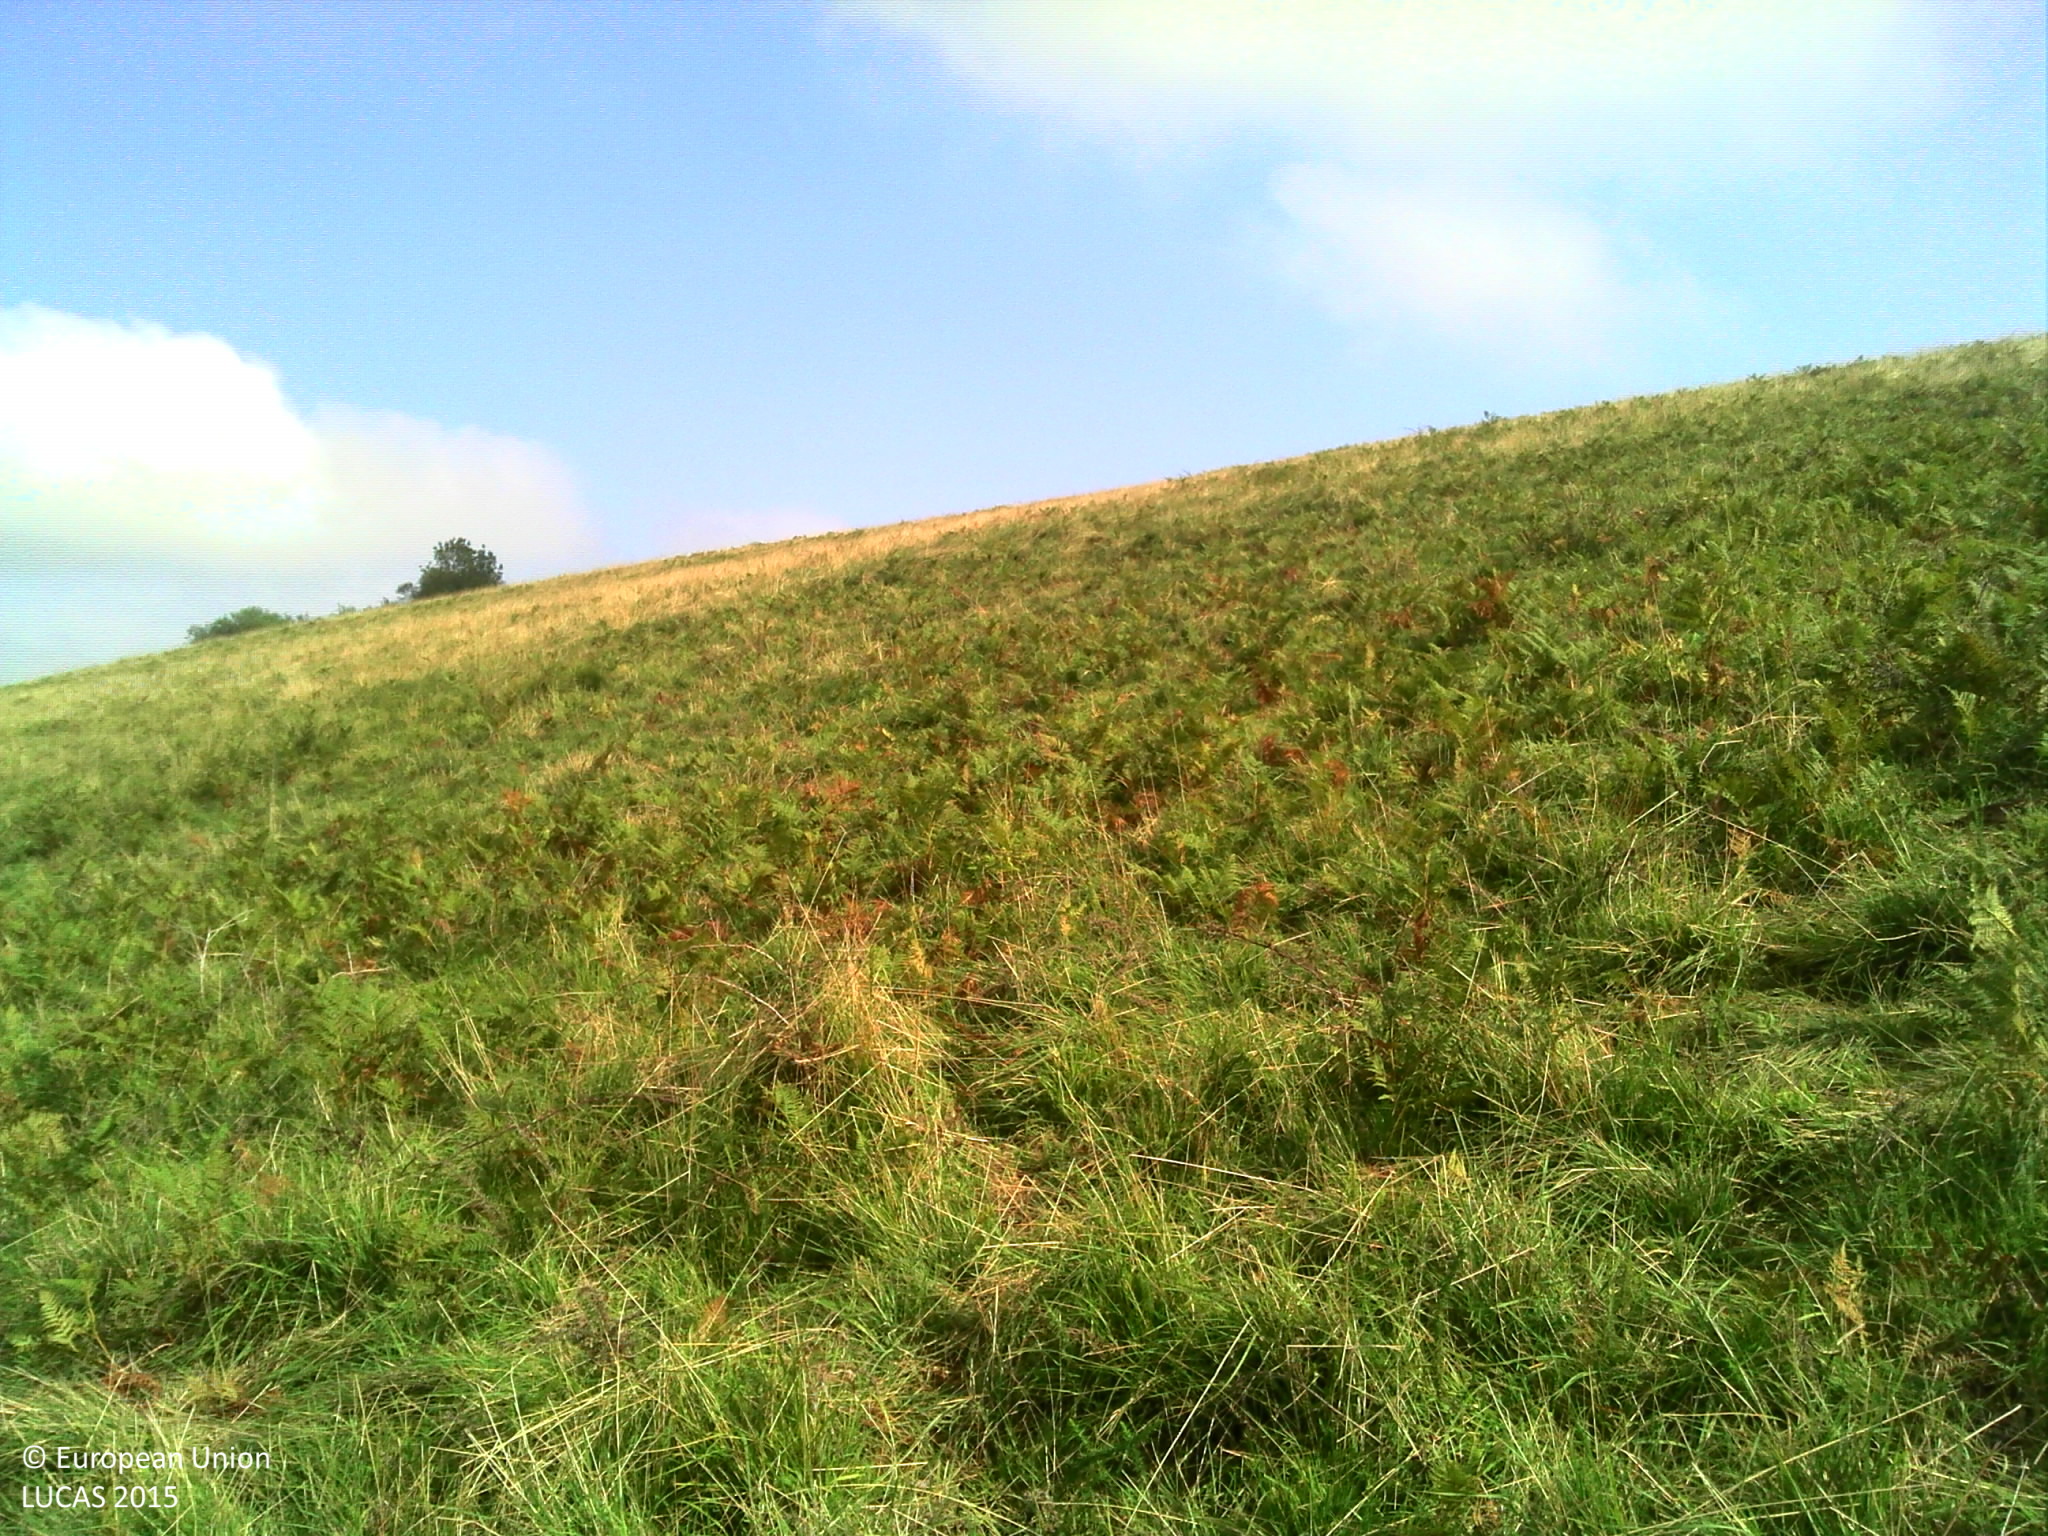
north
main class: Grassland
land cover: Grassland without tree/shrub cover
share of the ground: > 75 %
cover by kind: herbaceous plants 95 %, shrubs 5 %
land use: Agriculture (excluding fallow land and kitchen gardens)
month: September
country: FR
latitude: 43.2123
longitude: -1.0534
